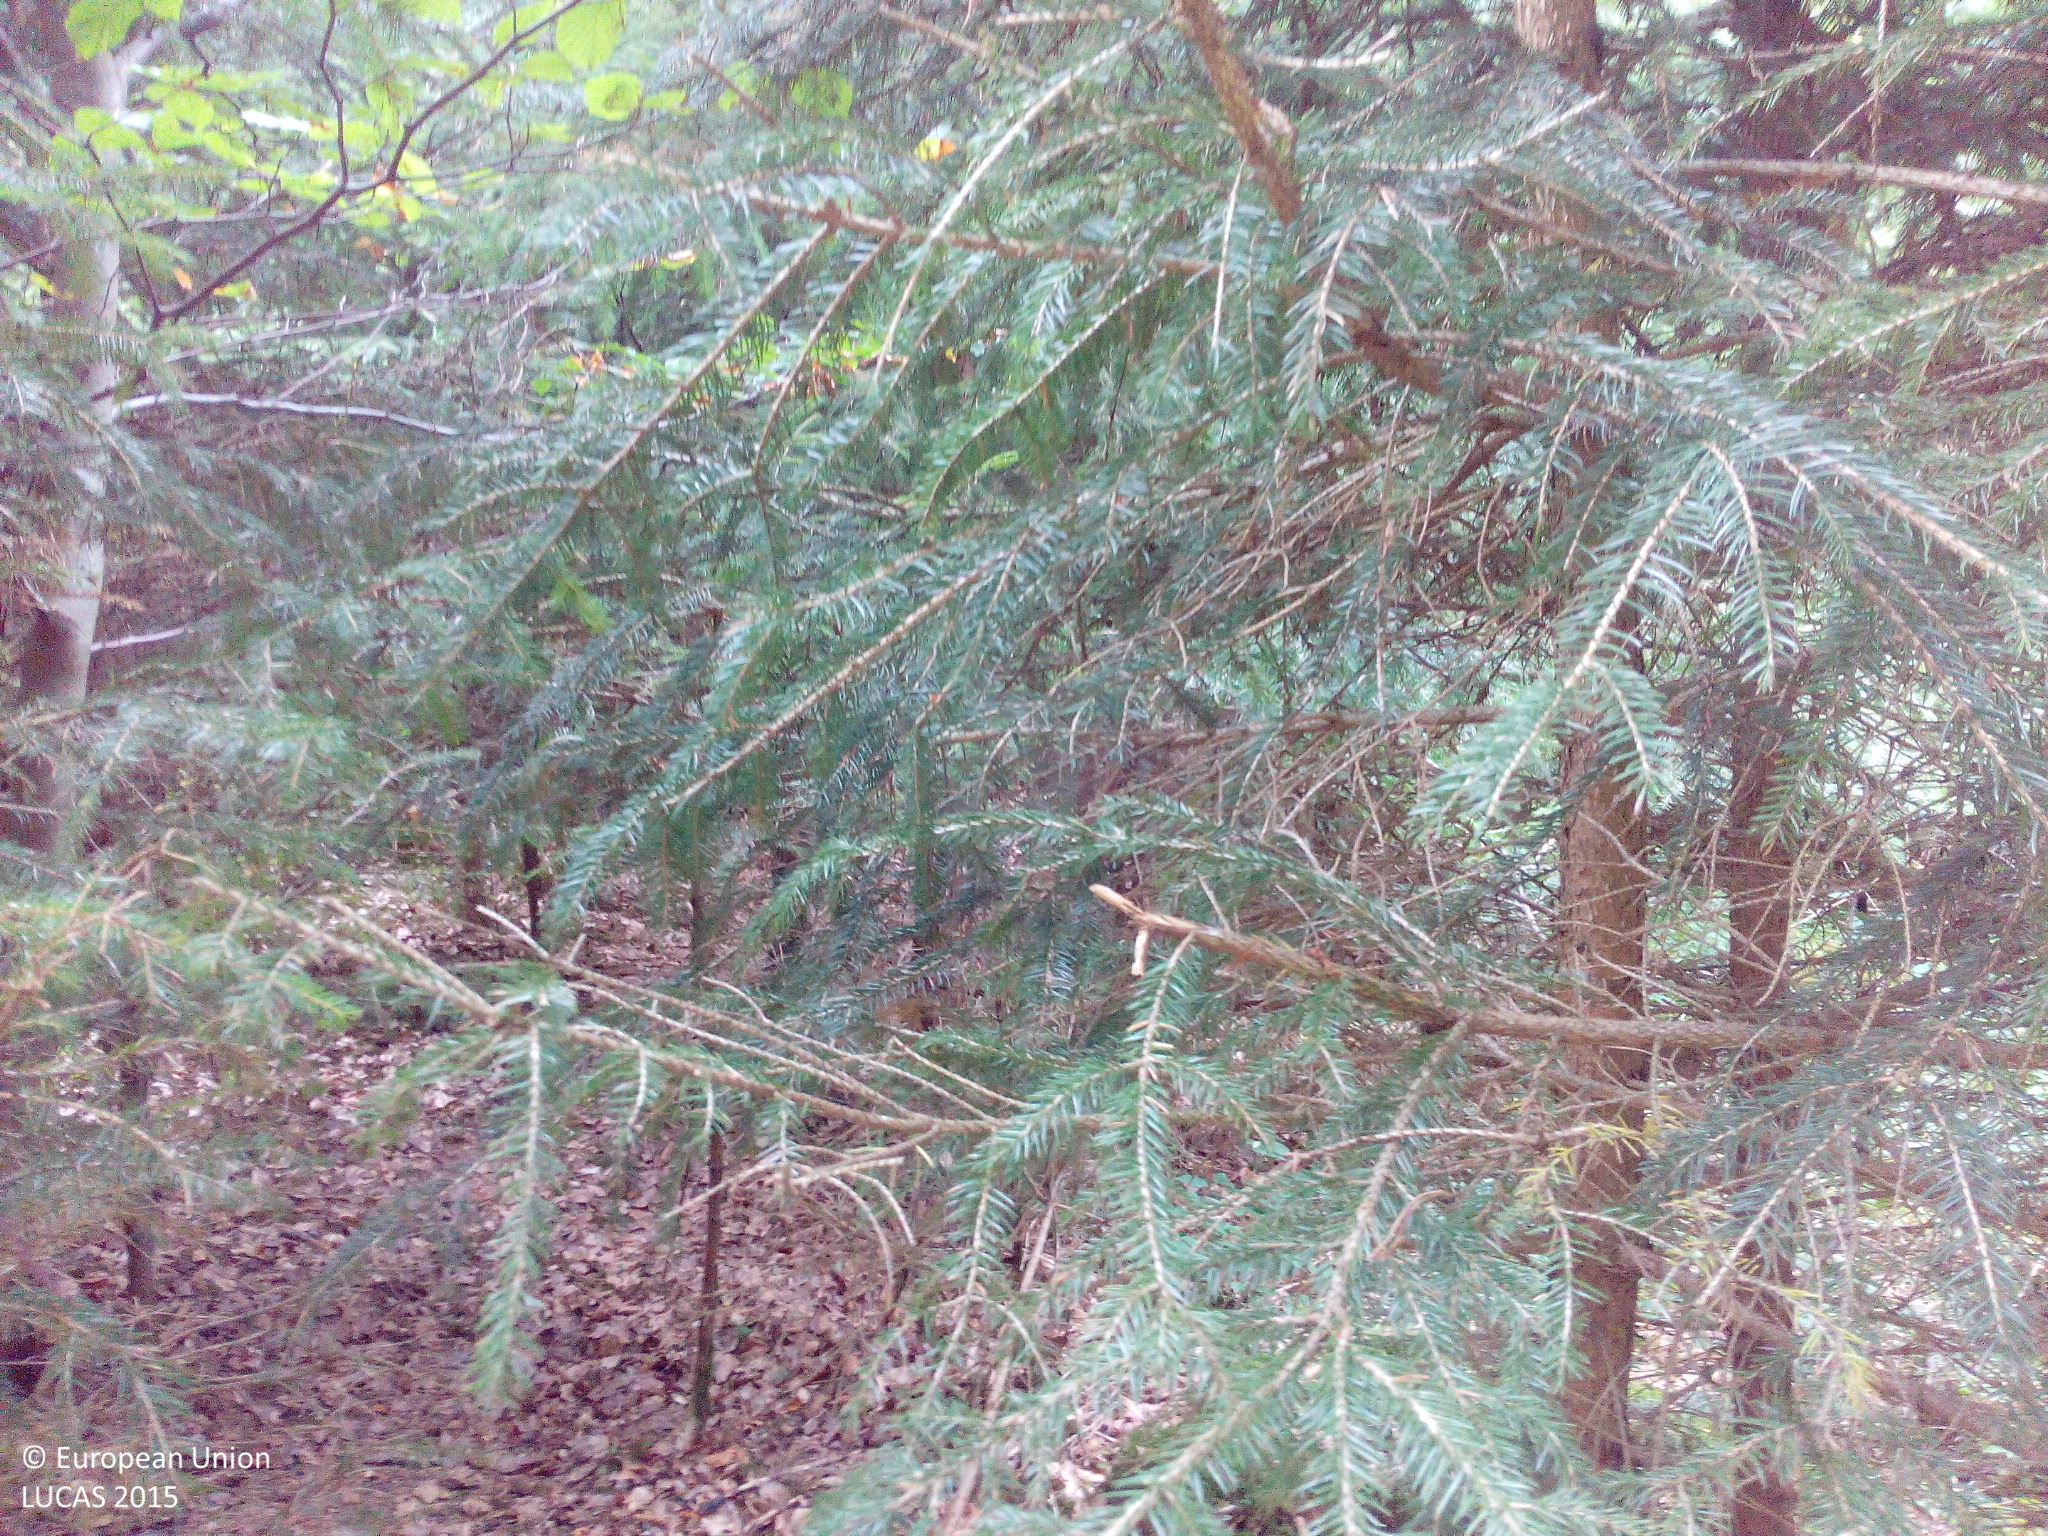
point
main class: Woodland
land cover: Spruce dominated coniferous woodland
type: hemiboreal forest and nemoral coniferous forest and mixed broadleaved-coniferous forest
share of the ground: > 75 %
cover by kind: coniferous forest trees 100 %
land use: Forestry
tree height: > 5 m
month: September
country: DE
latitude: 48.4836
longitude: 11.4740
